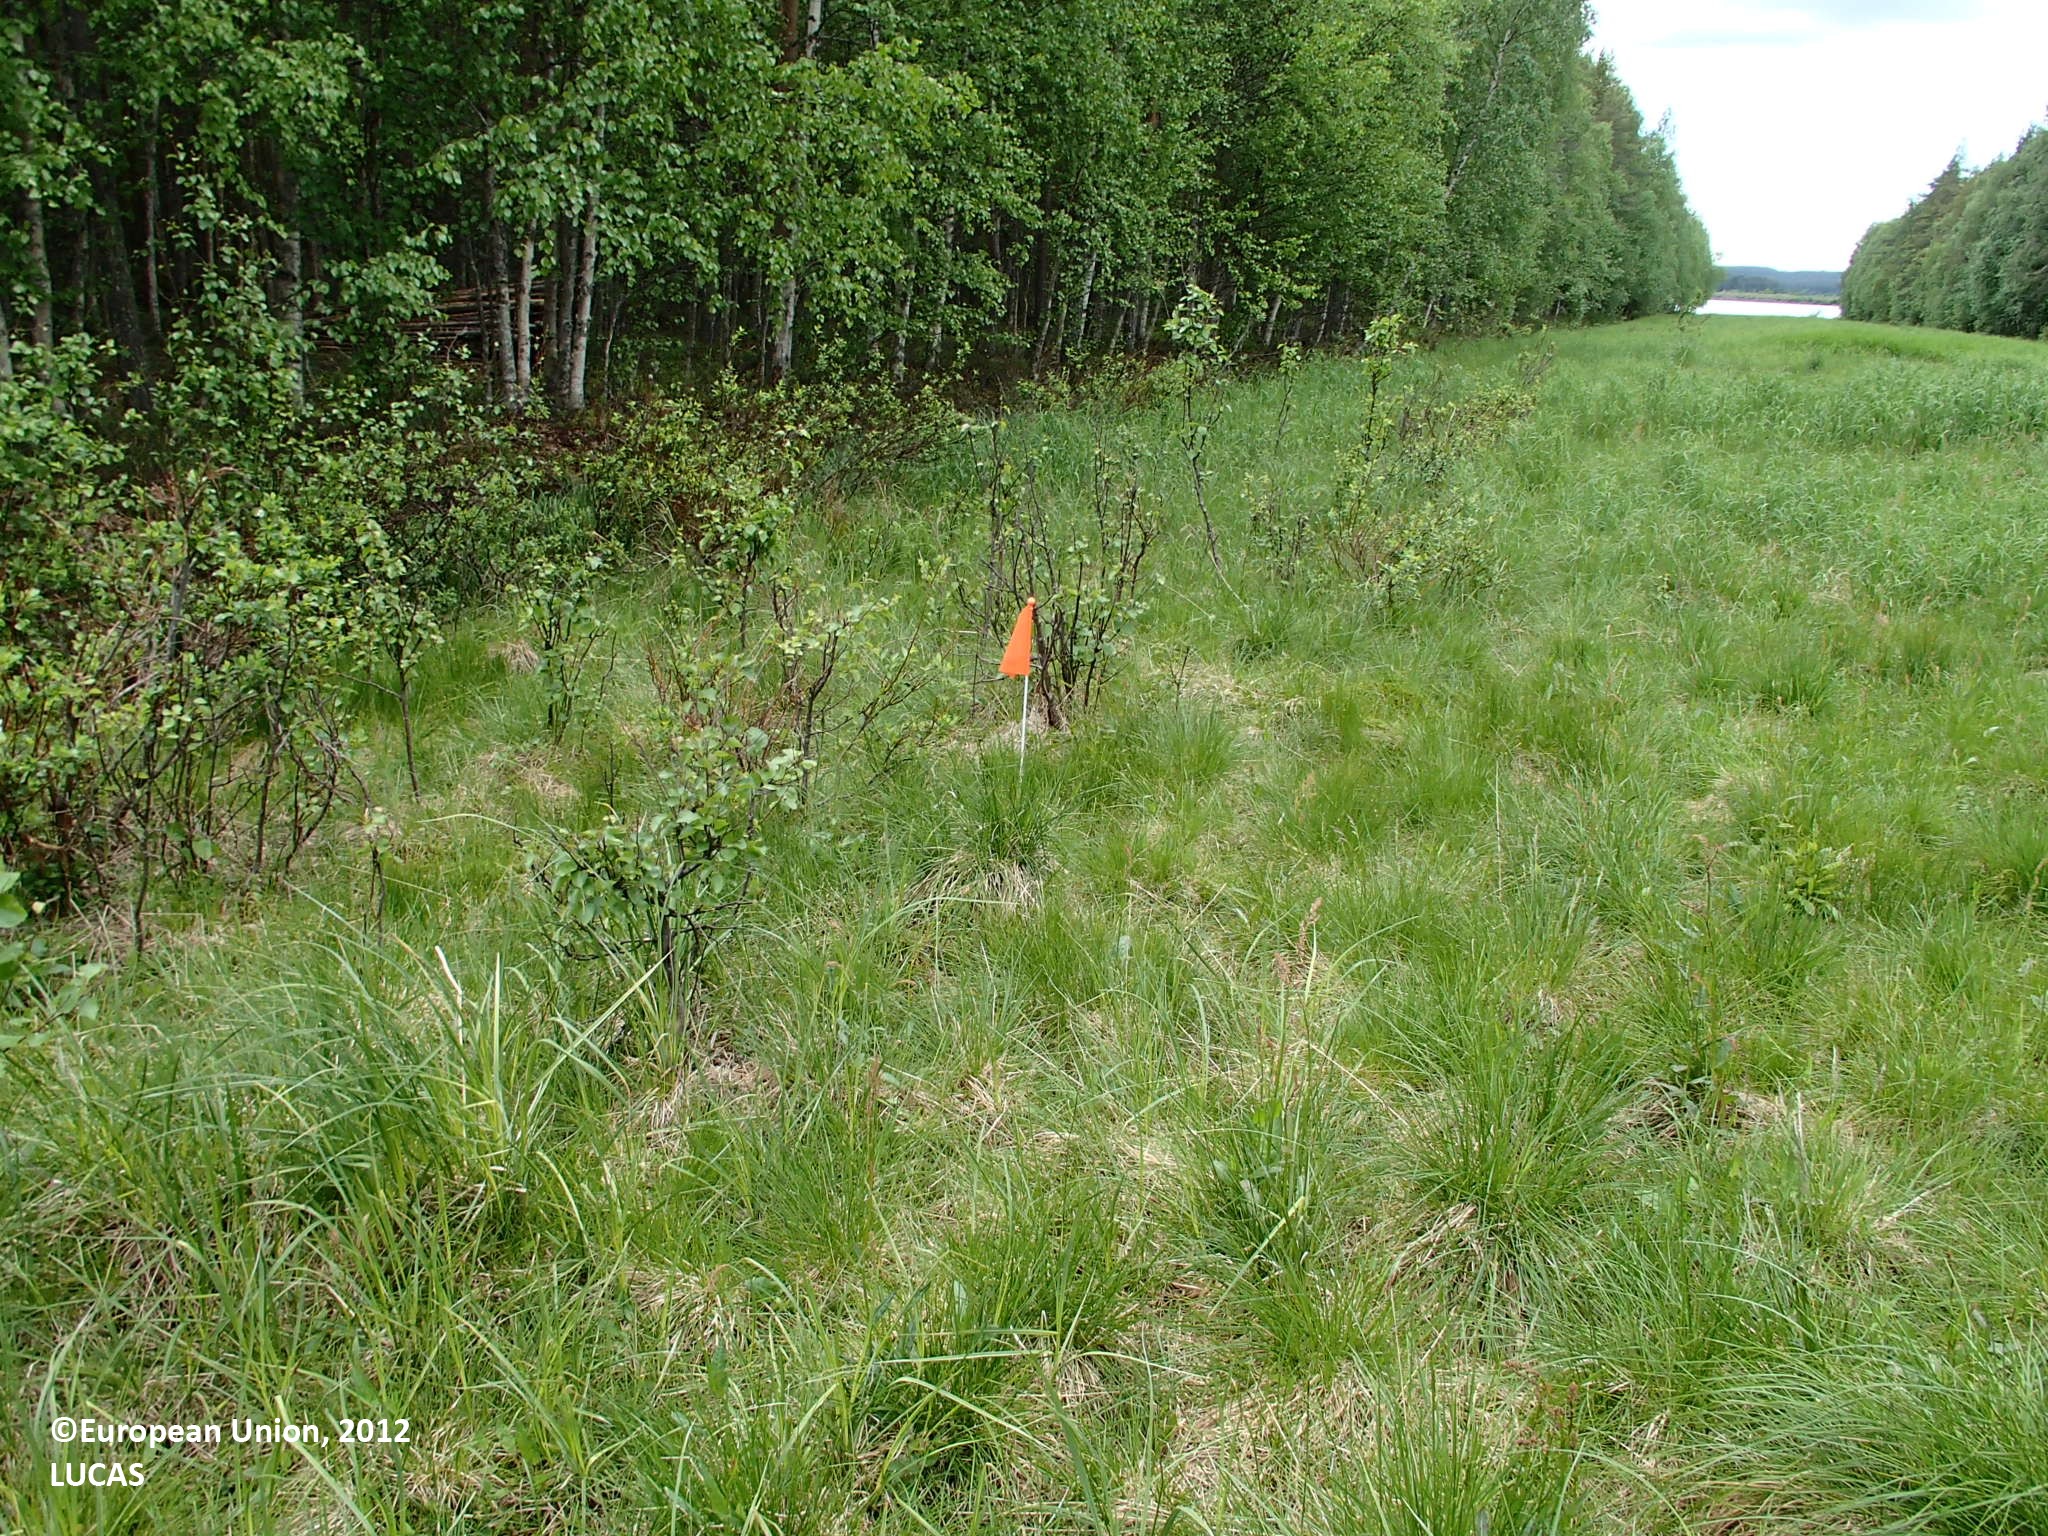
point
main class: Grassland
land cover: Grassland with sparse tree/shrub cover
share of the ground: > 75 %
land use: Abandoned areas
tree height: < 5 m
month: June
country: FI
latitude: 66.5303
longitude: 27.2758
